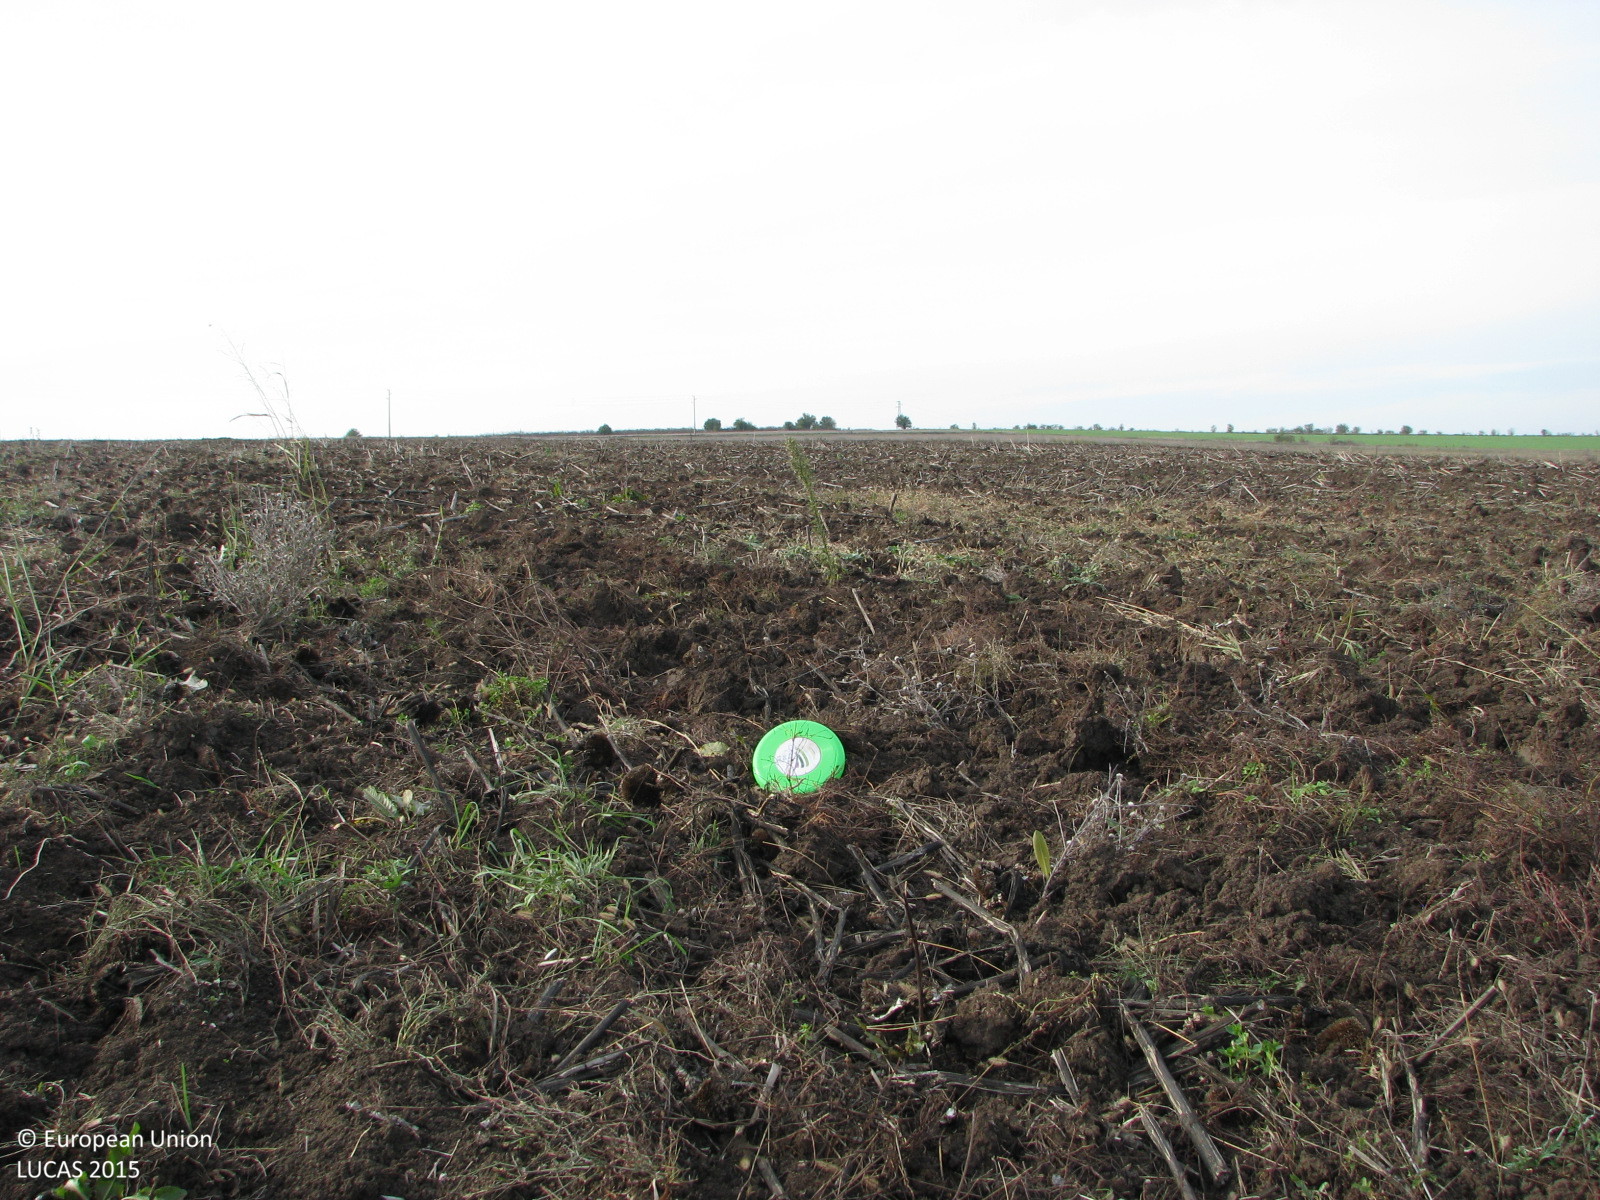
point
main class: Cropland
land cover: Sunflower
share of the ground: < 10 %
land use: Agriculture (excluding fallow land and kitchen gardens)
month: October
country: BG
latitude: 42.5018
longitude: 26.7328
